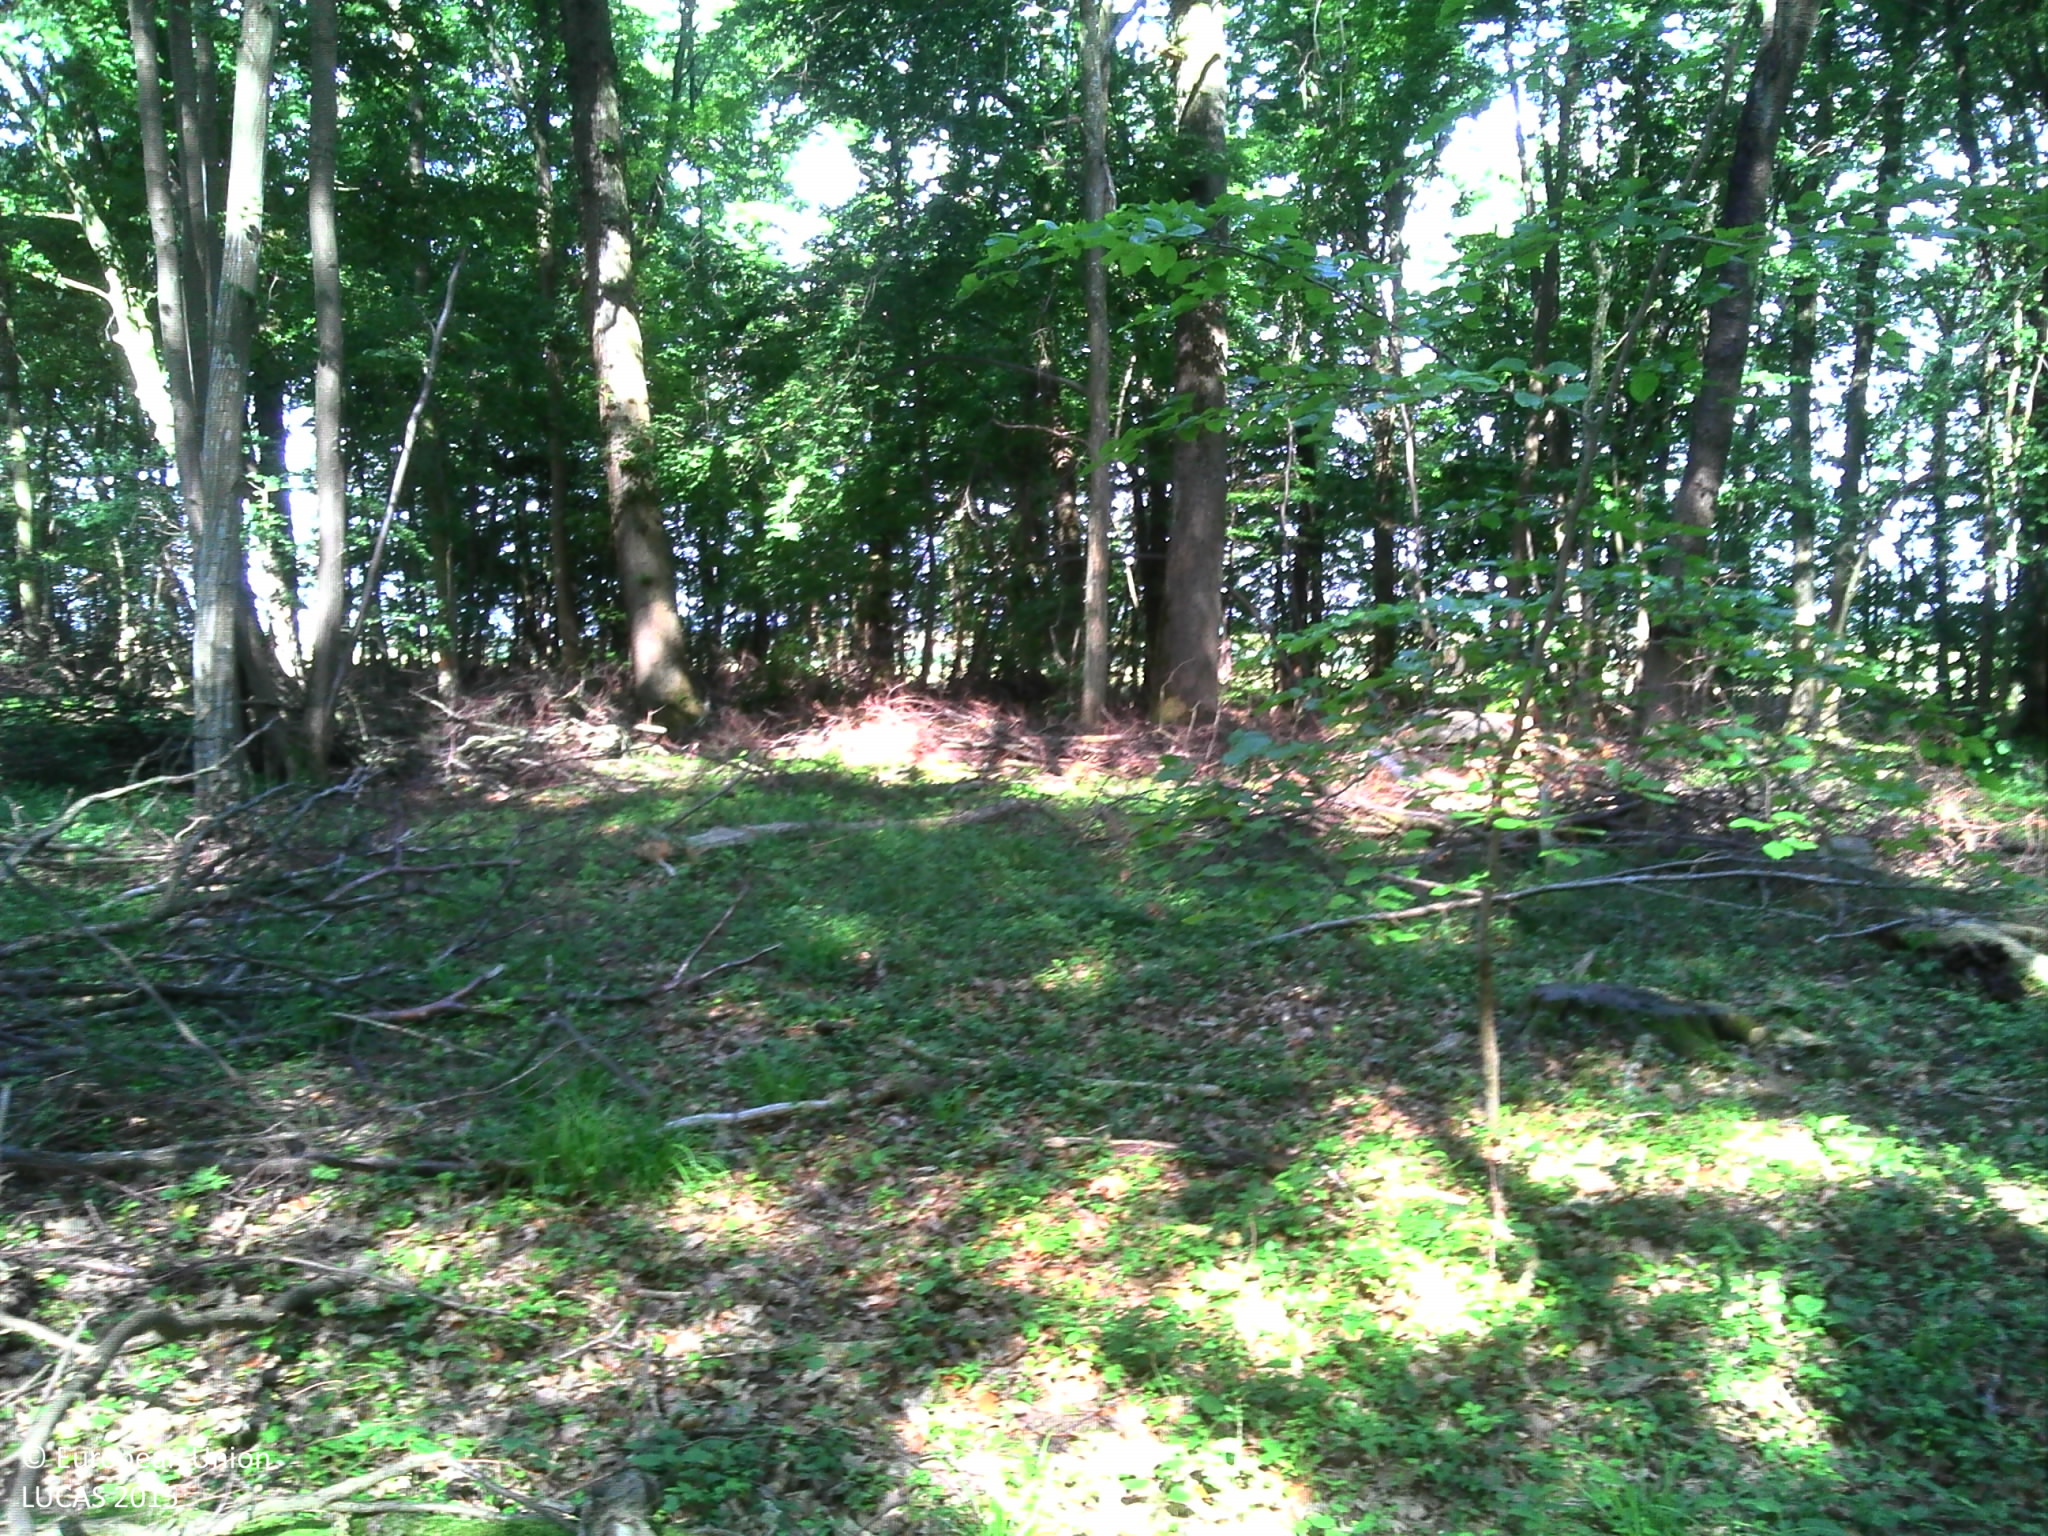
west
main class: Woodland
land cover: Broadleaved woodland
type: acidophilous oak and oak-birch forest
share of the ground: > 75 %
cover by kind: broadleaved forest trees 90 %, herbaceous plants 5 %, lichens and mosses 5 %
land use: Forestry
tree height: > 5 m
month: June
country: FR
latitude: 48.6897
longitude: 6.4819
